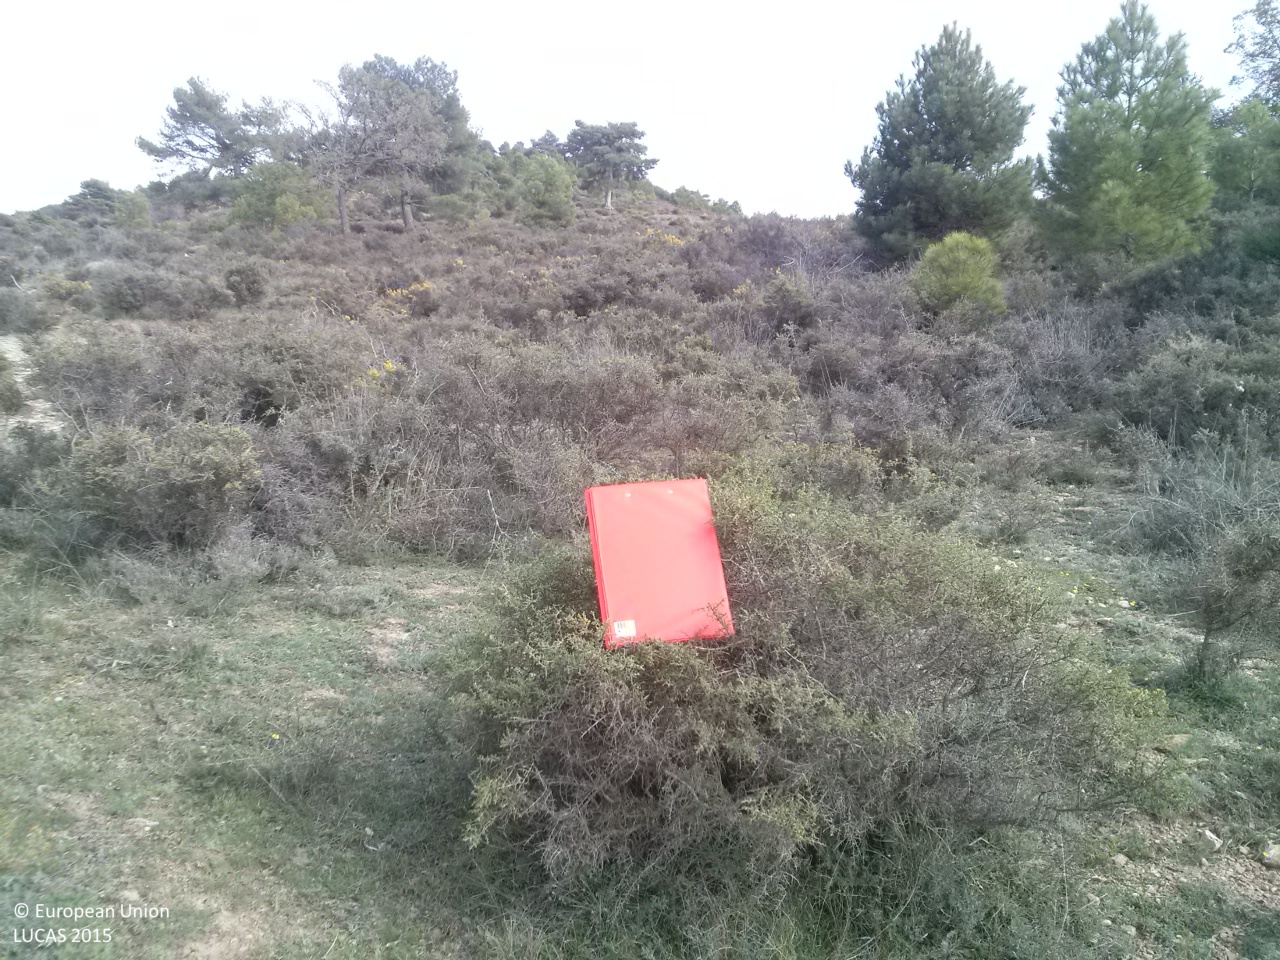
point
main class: Shrubland
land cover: Shrubland without tree cover
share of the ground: 50 - 75 %
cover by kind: shrubs 60 %, herbaceous plants 30 %, unconsolidated bare surface 10 %
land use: Agriculture (excluding fallow land and kitchen gardens)
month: April
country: ES
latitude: 40.1237
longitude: -1.7594
